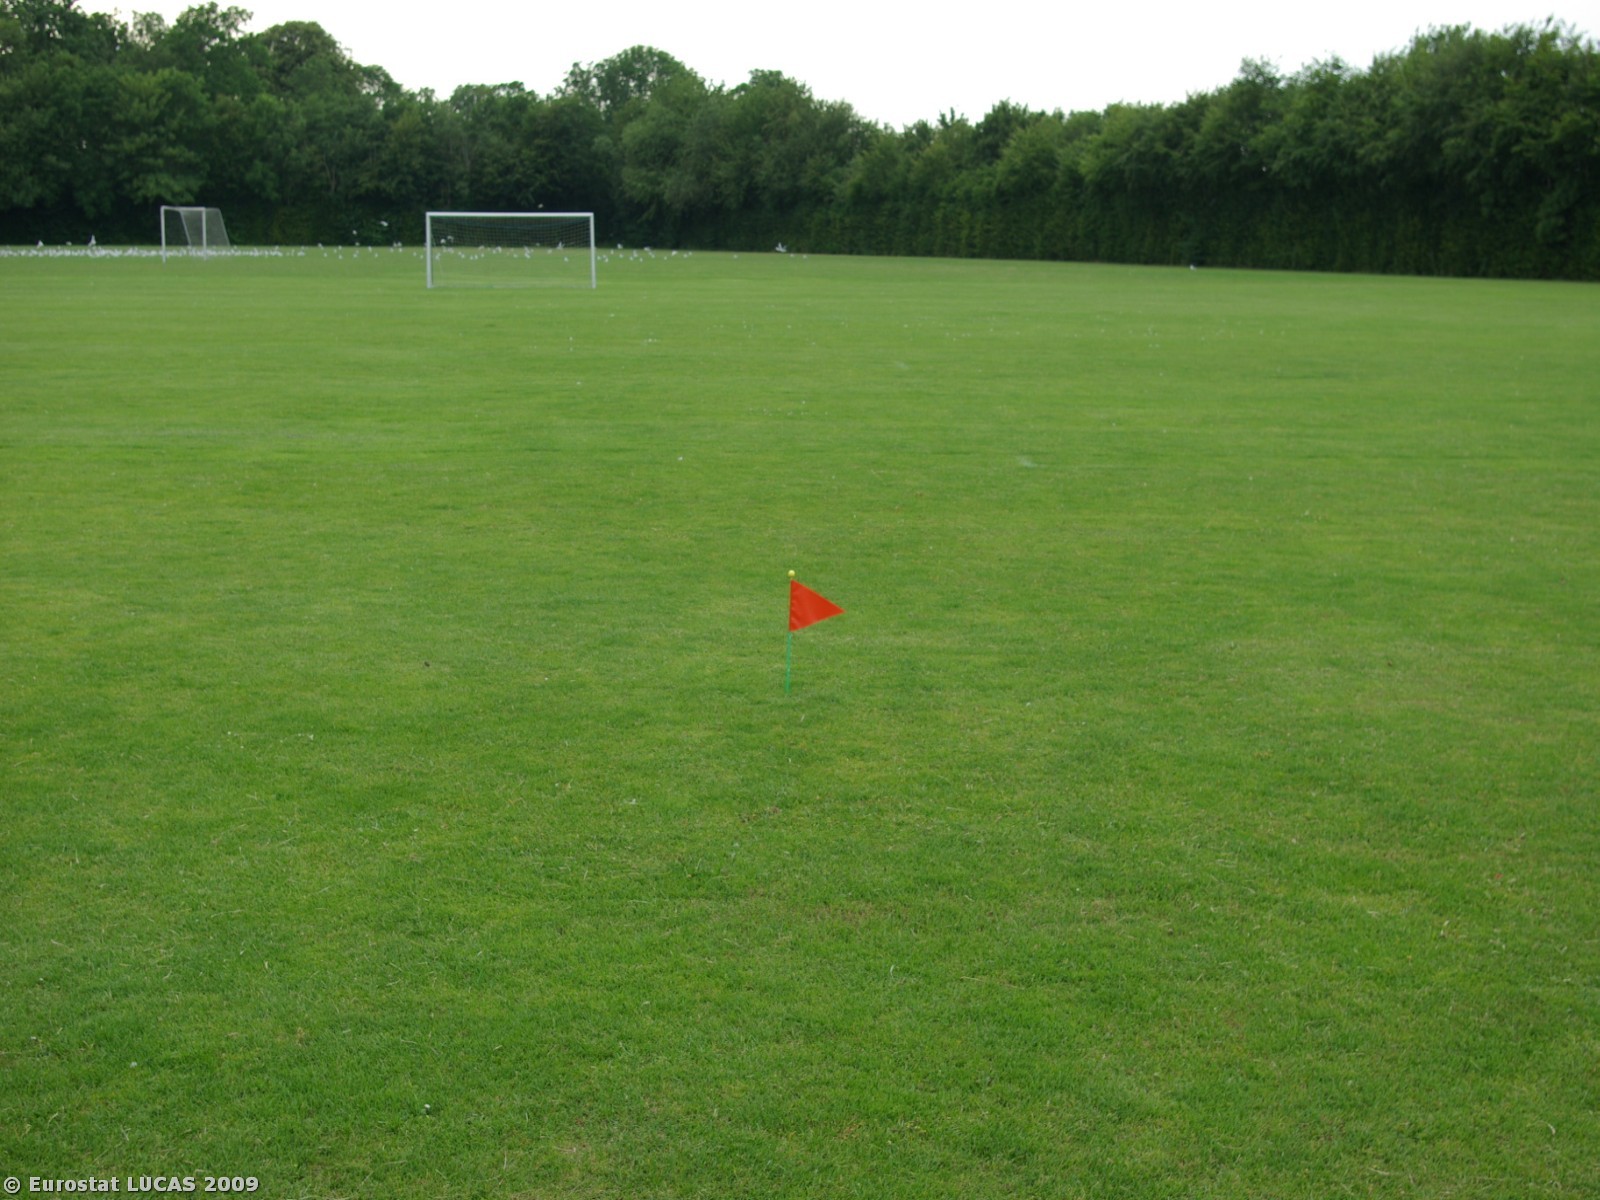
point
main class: Grassland
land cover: Grassland without tree/shrub cover
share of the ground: > 75 %
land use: Sport
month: July
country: DK
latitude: 55.0551
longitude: 9.7654
